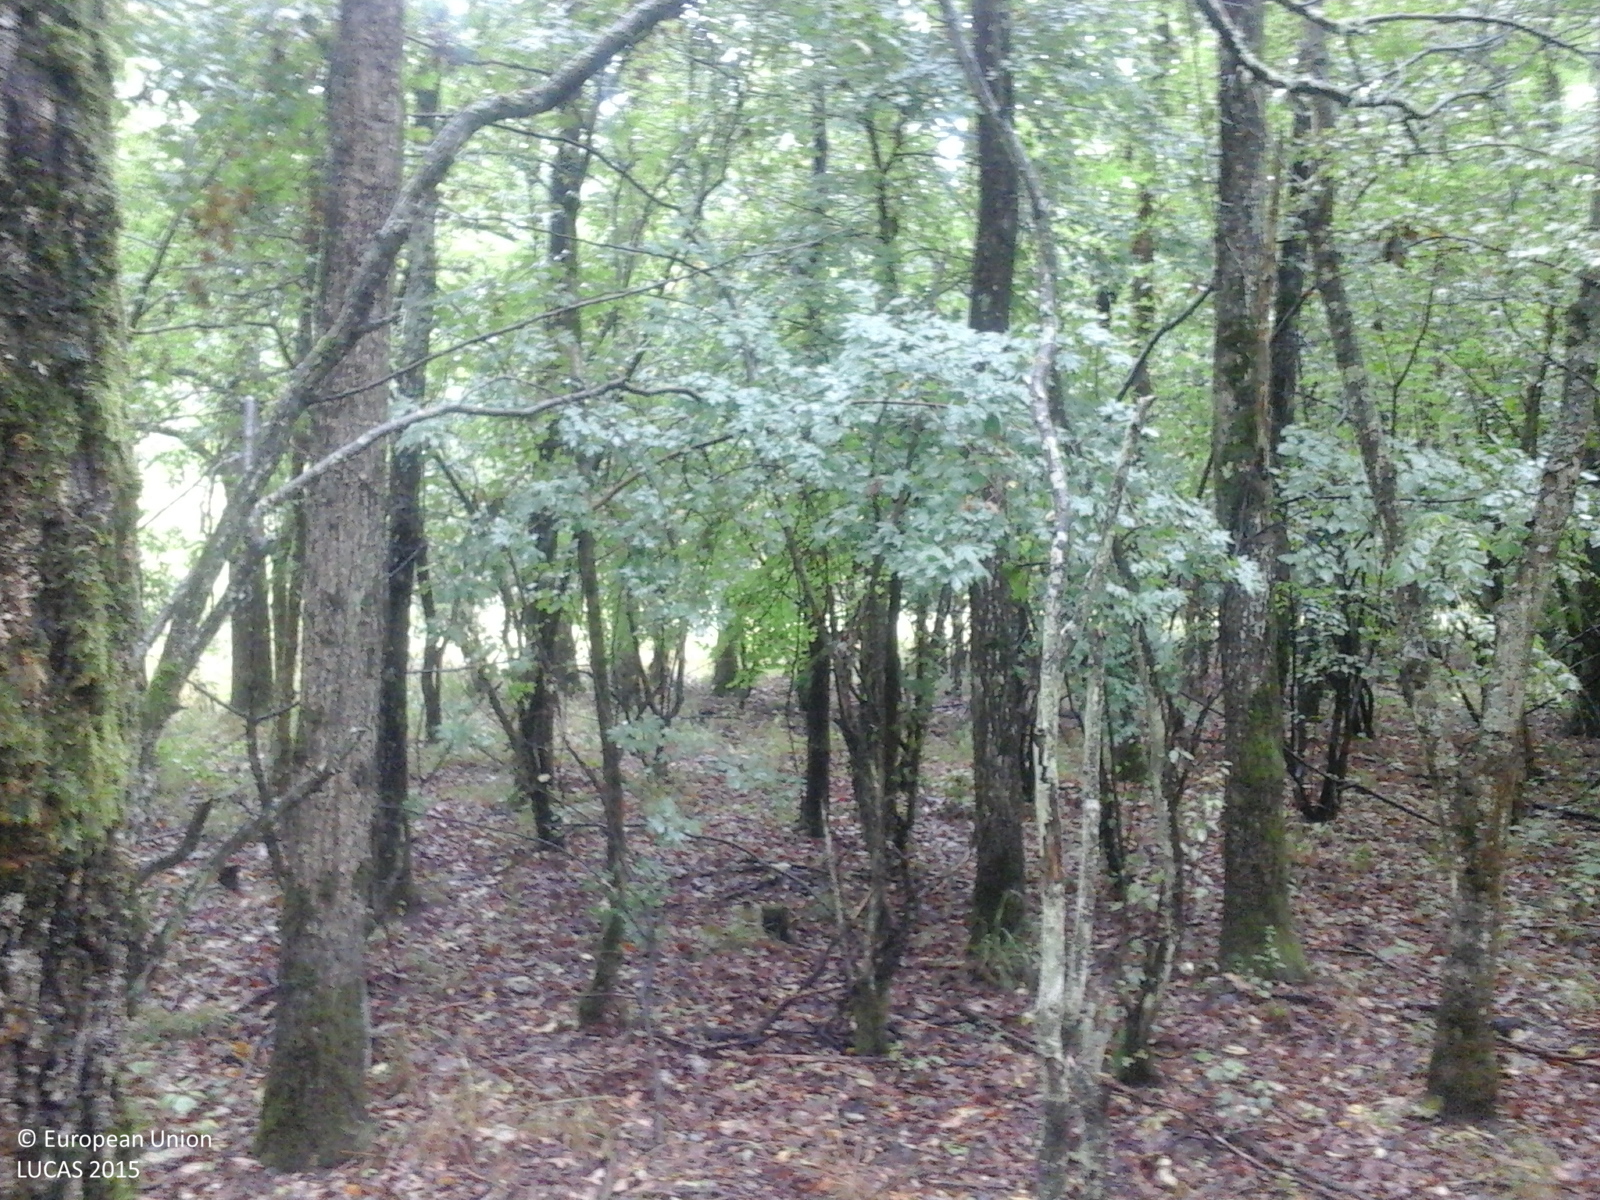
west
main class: Woodland
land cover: Broadleaved woodland
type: acidophilous oak and oak-birch forest
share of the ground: > 75 %
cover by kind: broadleaved forest trees 100 %
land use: Forestry
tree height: > 5 m
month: August
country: RO
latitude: 45.7128
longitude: 21.4792
